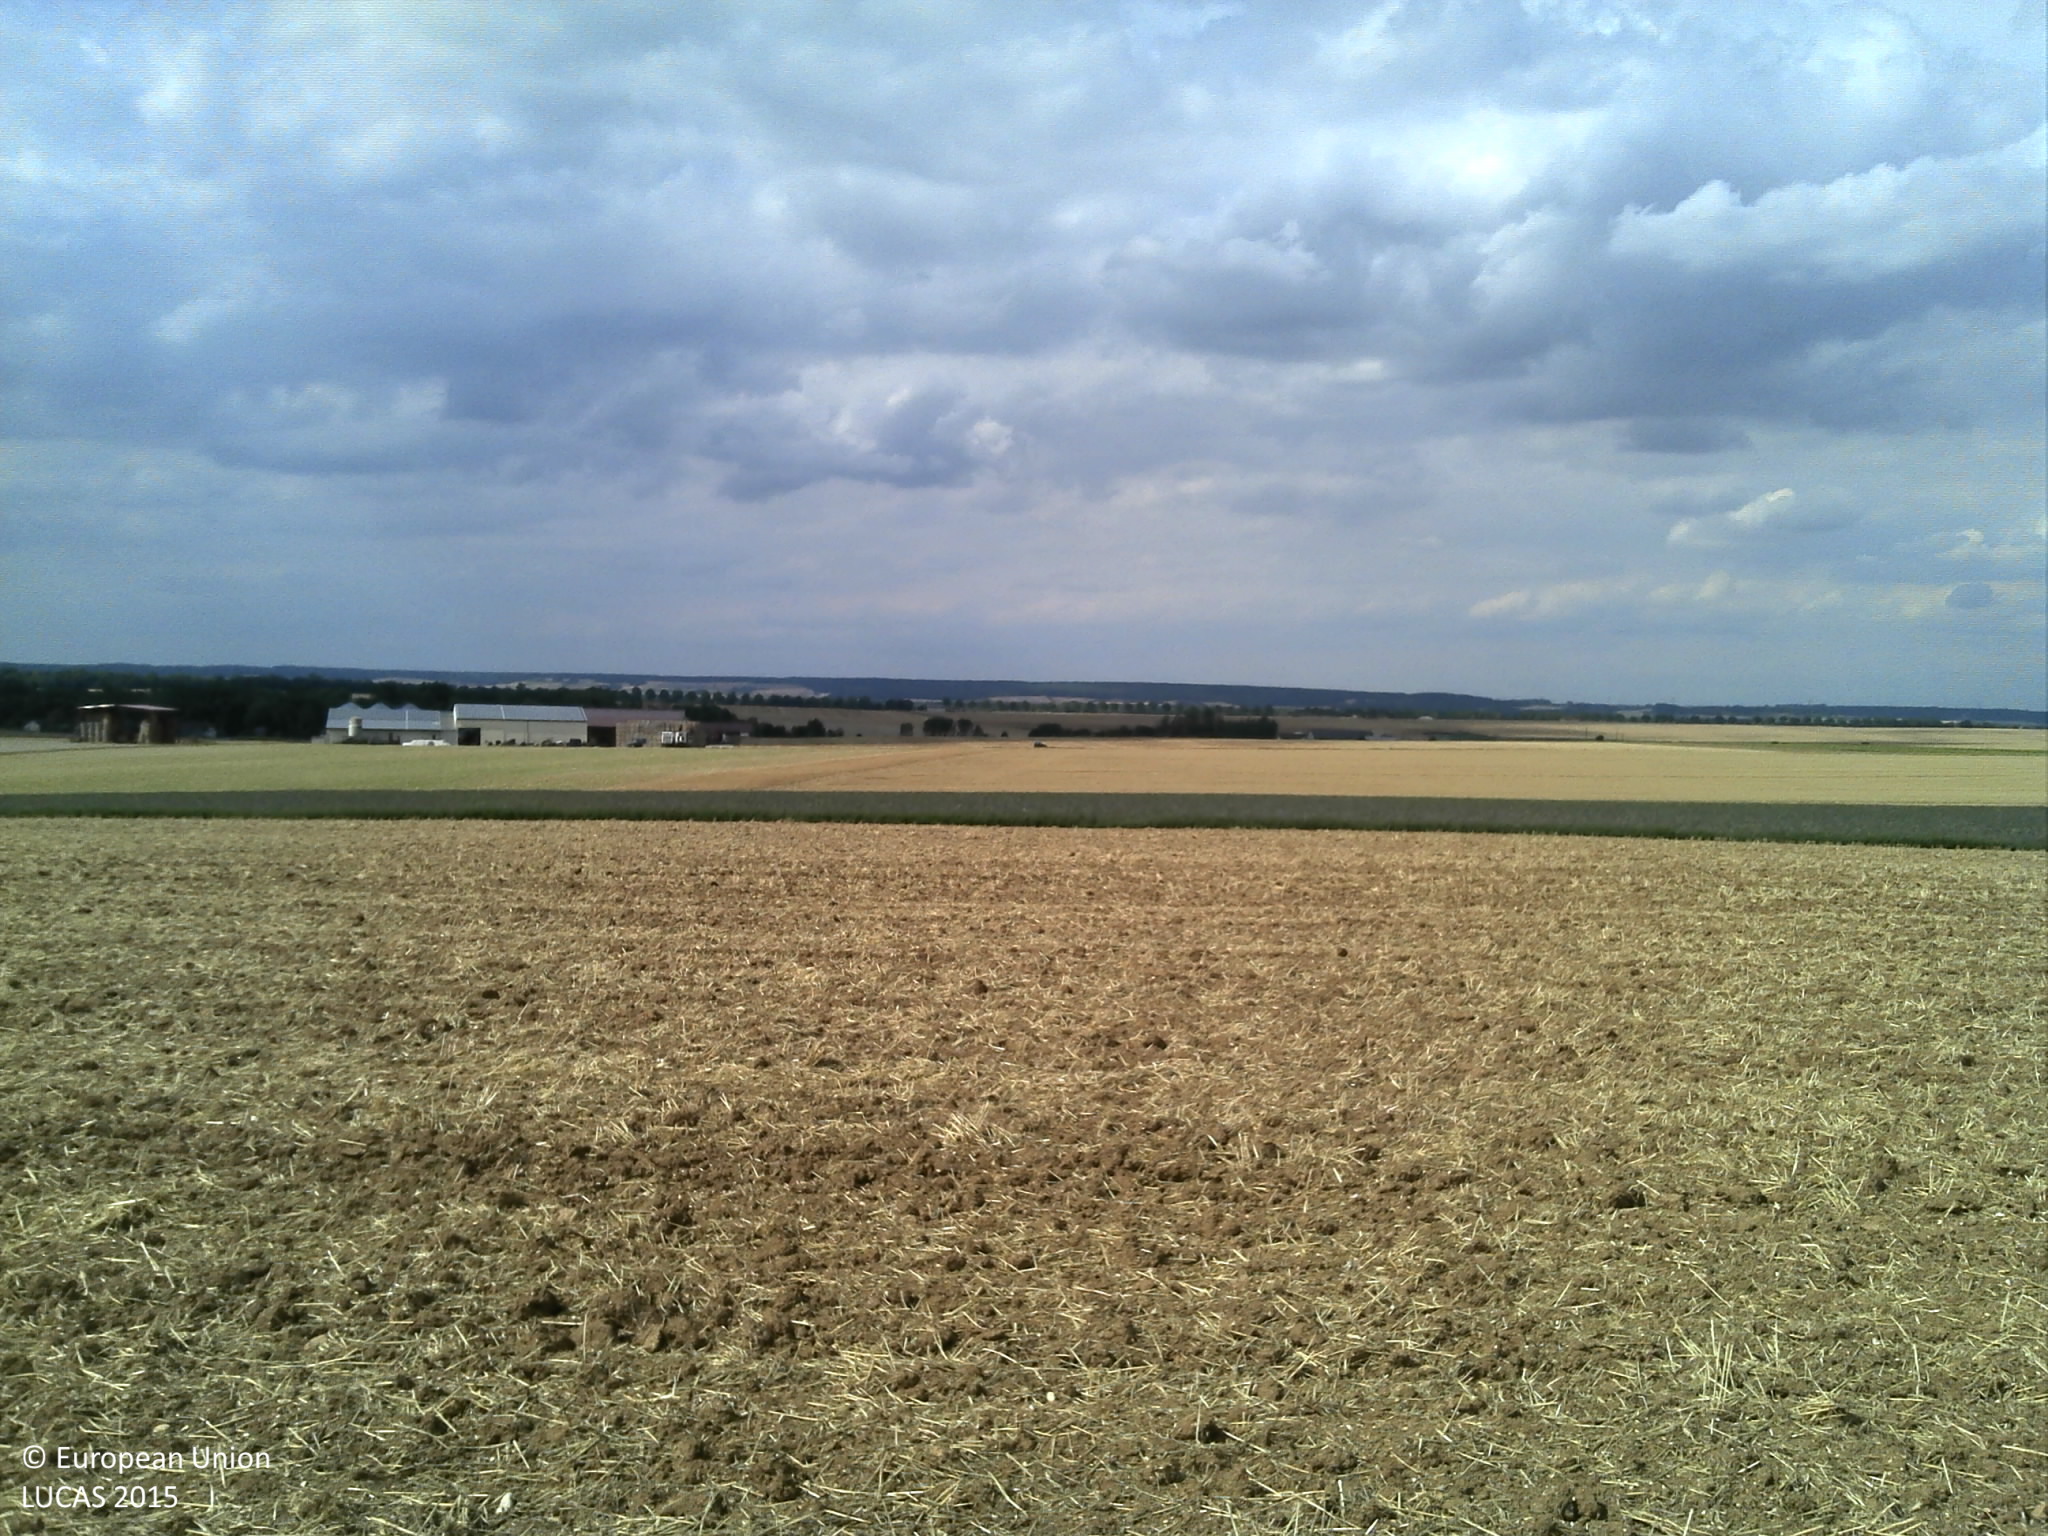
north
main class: Cropland
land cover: Common wheat
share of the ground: 25 - 50 %
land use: Agriculture (excluding fallow land and kitchen gardens)
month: August
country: FR
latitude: 48.4447
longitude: 3.4643
